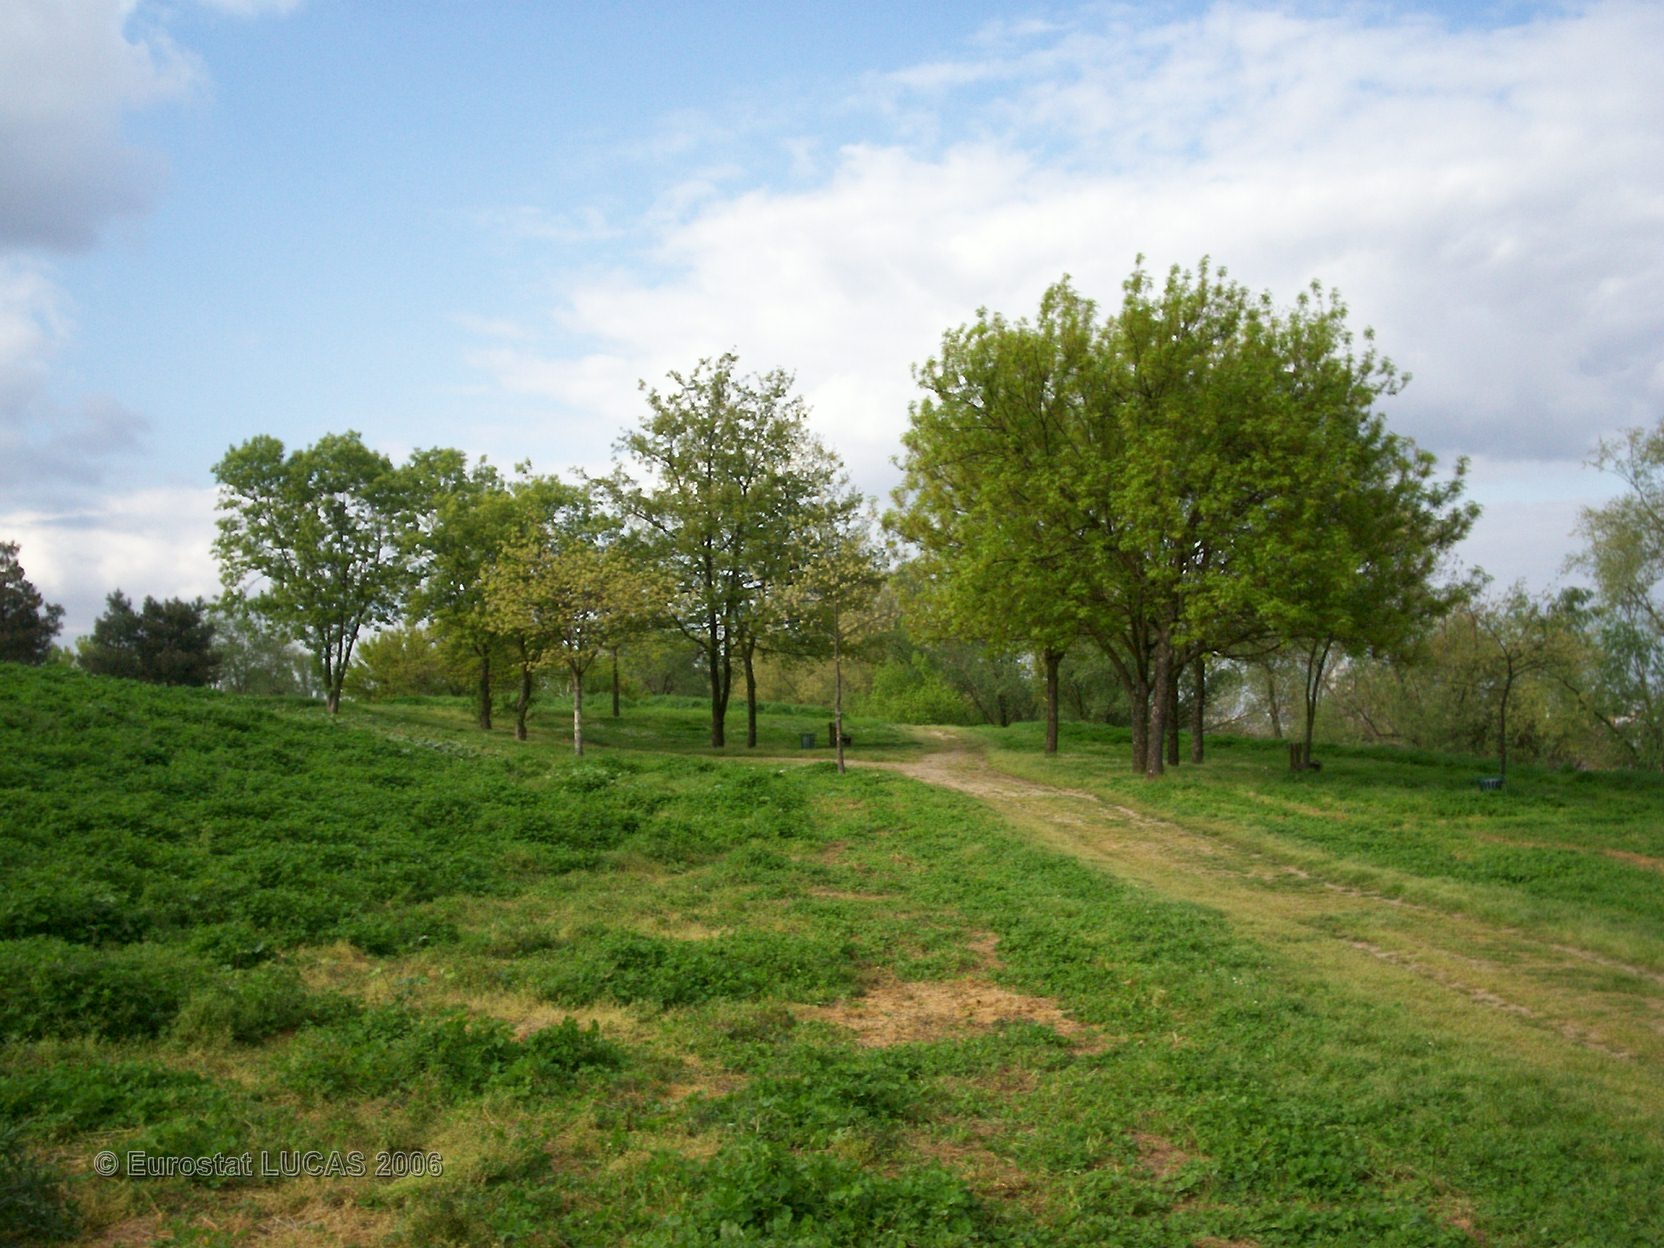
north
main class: Grassland
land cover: Grassland without tree/shrub cover
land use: Amenities, museums, leisure
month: April
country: FR
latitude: 44.8846
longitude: -0.5393
